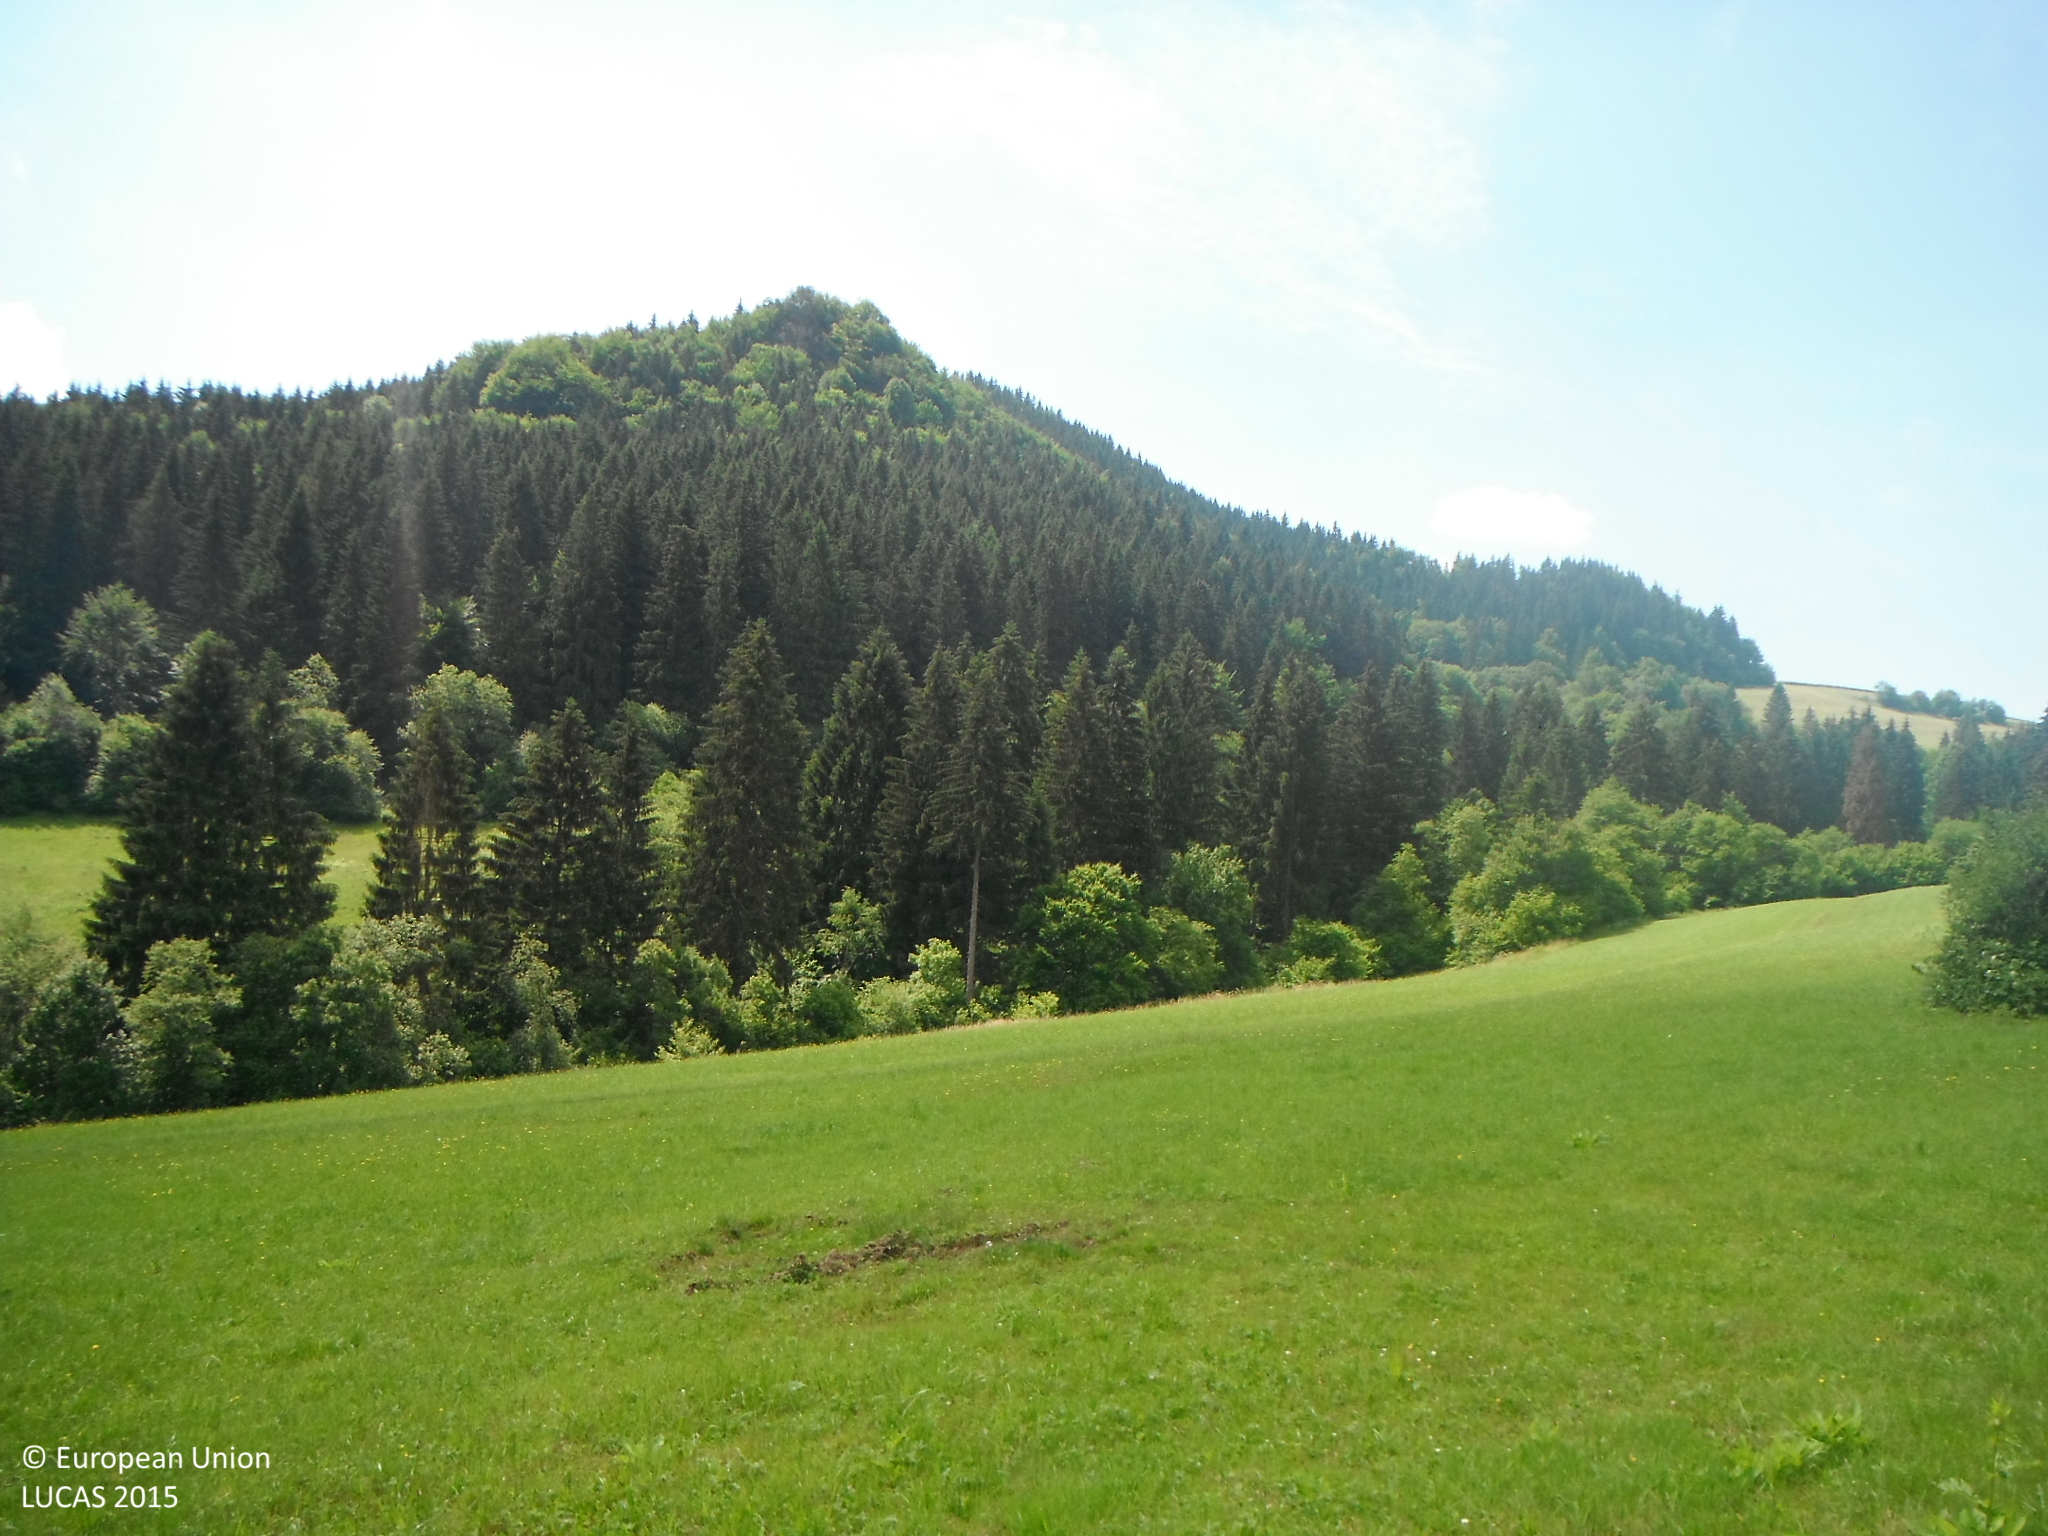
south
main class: Grassland
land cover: Grassland without tree/shrub cover
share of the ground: > 75 %
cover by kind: herbaceous plants 100 %
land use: Agriculture (excluding fallow land and kitchen gardens)
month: June
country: SK
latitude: 49.2845
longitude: 19.4429
